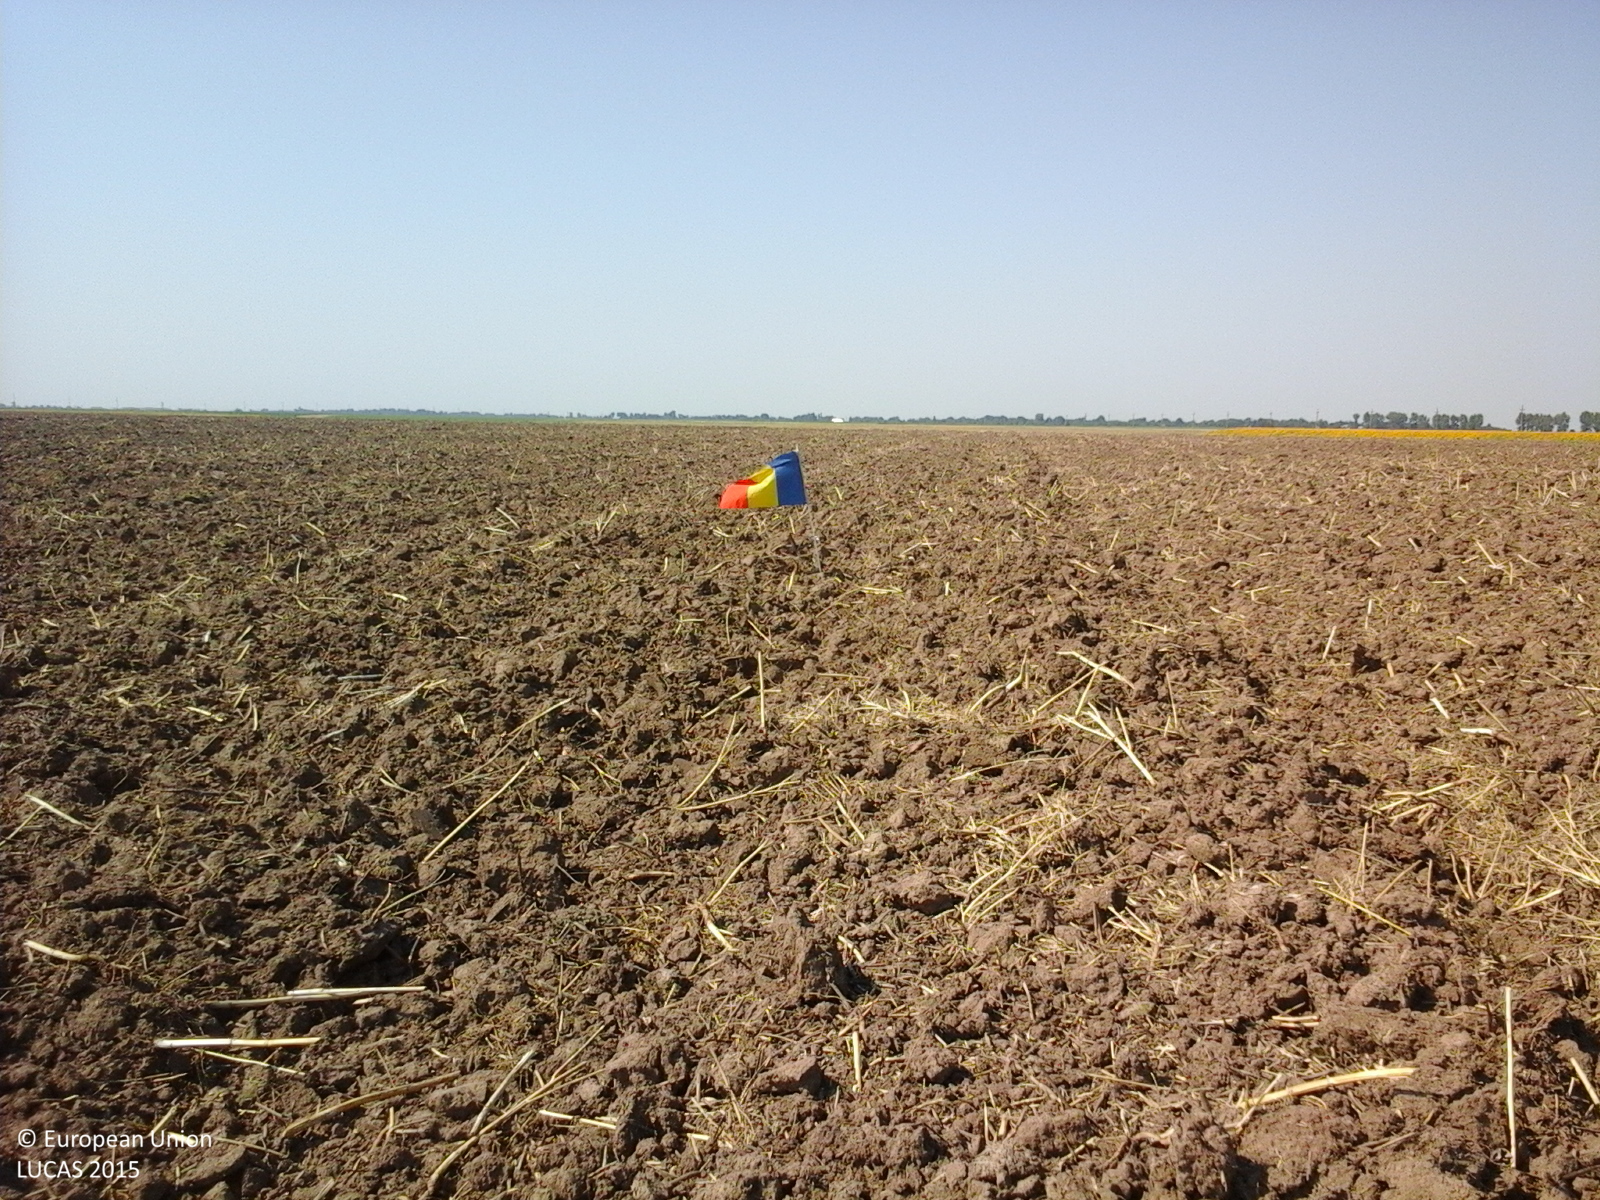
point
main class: Cropland
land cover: Rape and turnip rape
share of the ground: < 10 %
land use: Agriculture (excluding fallow land and kitchen gardens)
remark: Harvested field
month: July
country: RO
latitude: 44.3868
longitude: 25.2617
